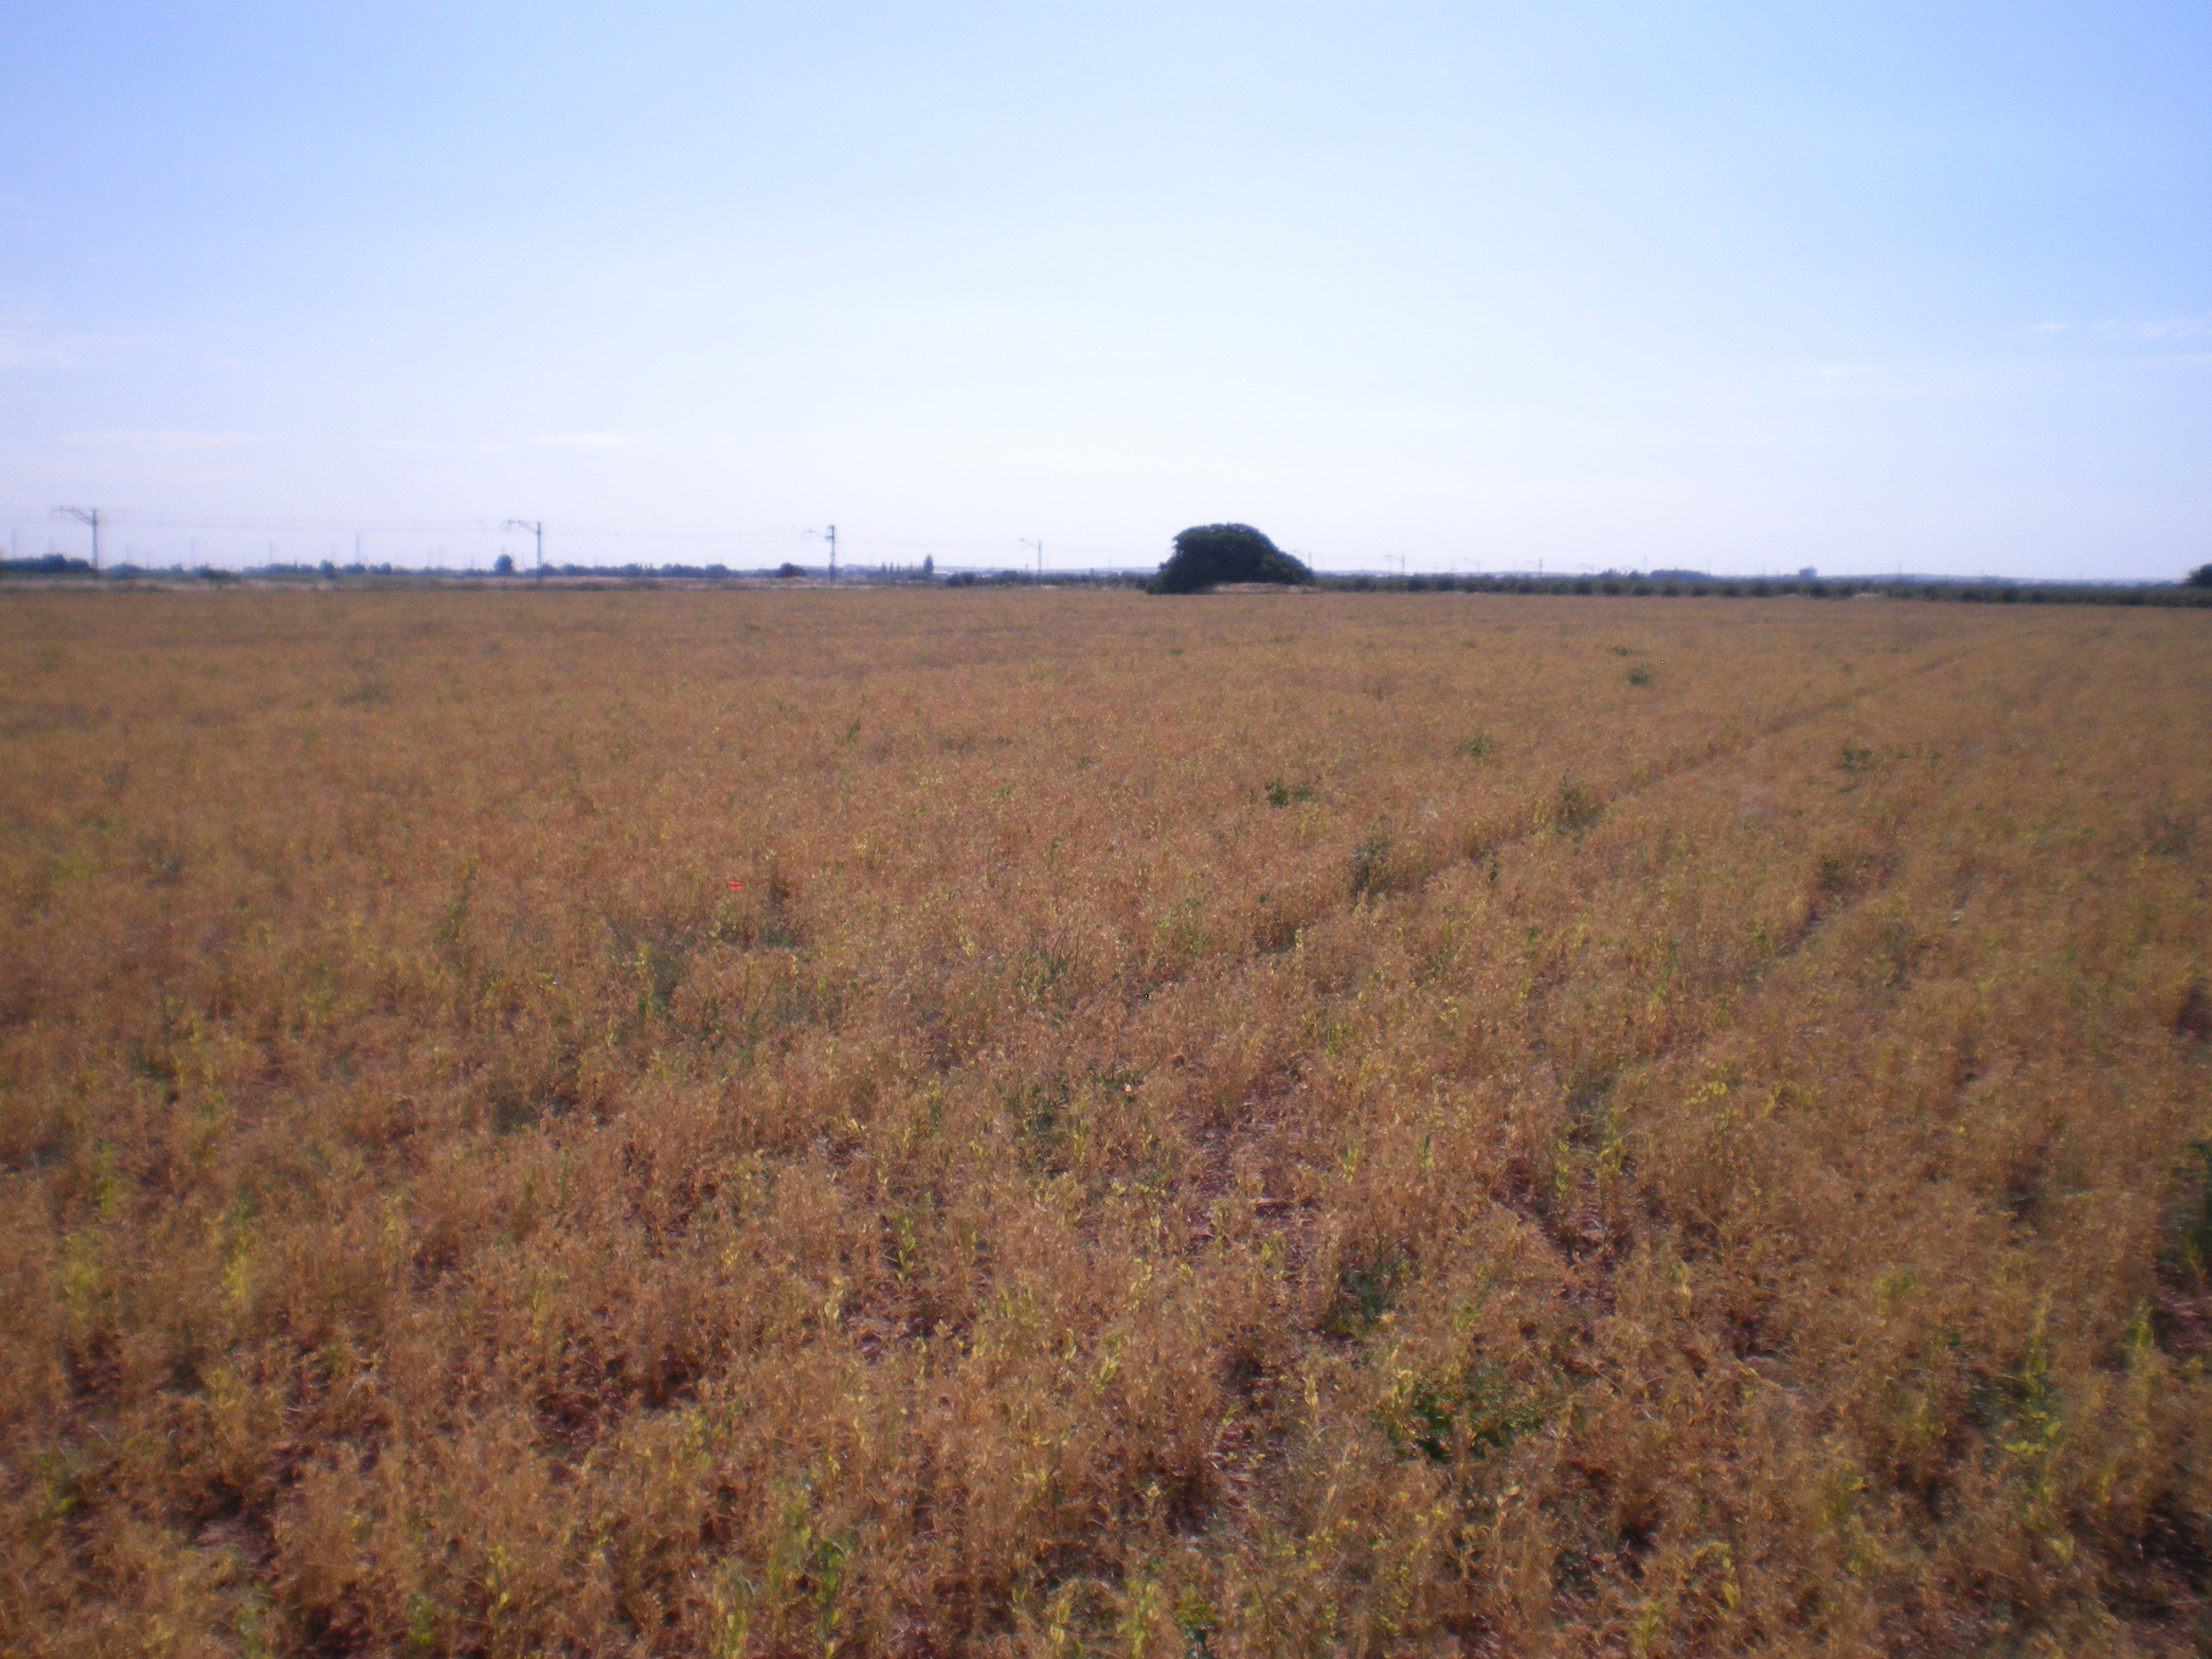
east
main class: Cropland
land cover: Dry pulses
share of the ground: > 75 %
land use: Agriculture (excluding fallow land and kitchen gardens)
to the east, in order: Dry pulses; Single bushes/trees
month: May
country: ES
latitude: 39.0106
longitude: -3.4226
